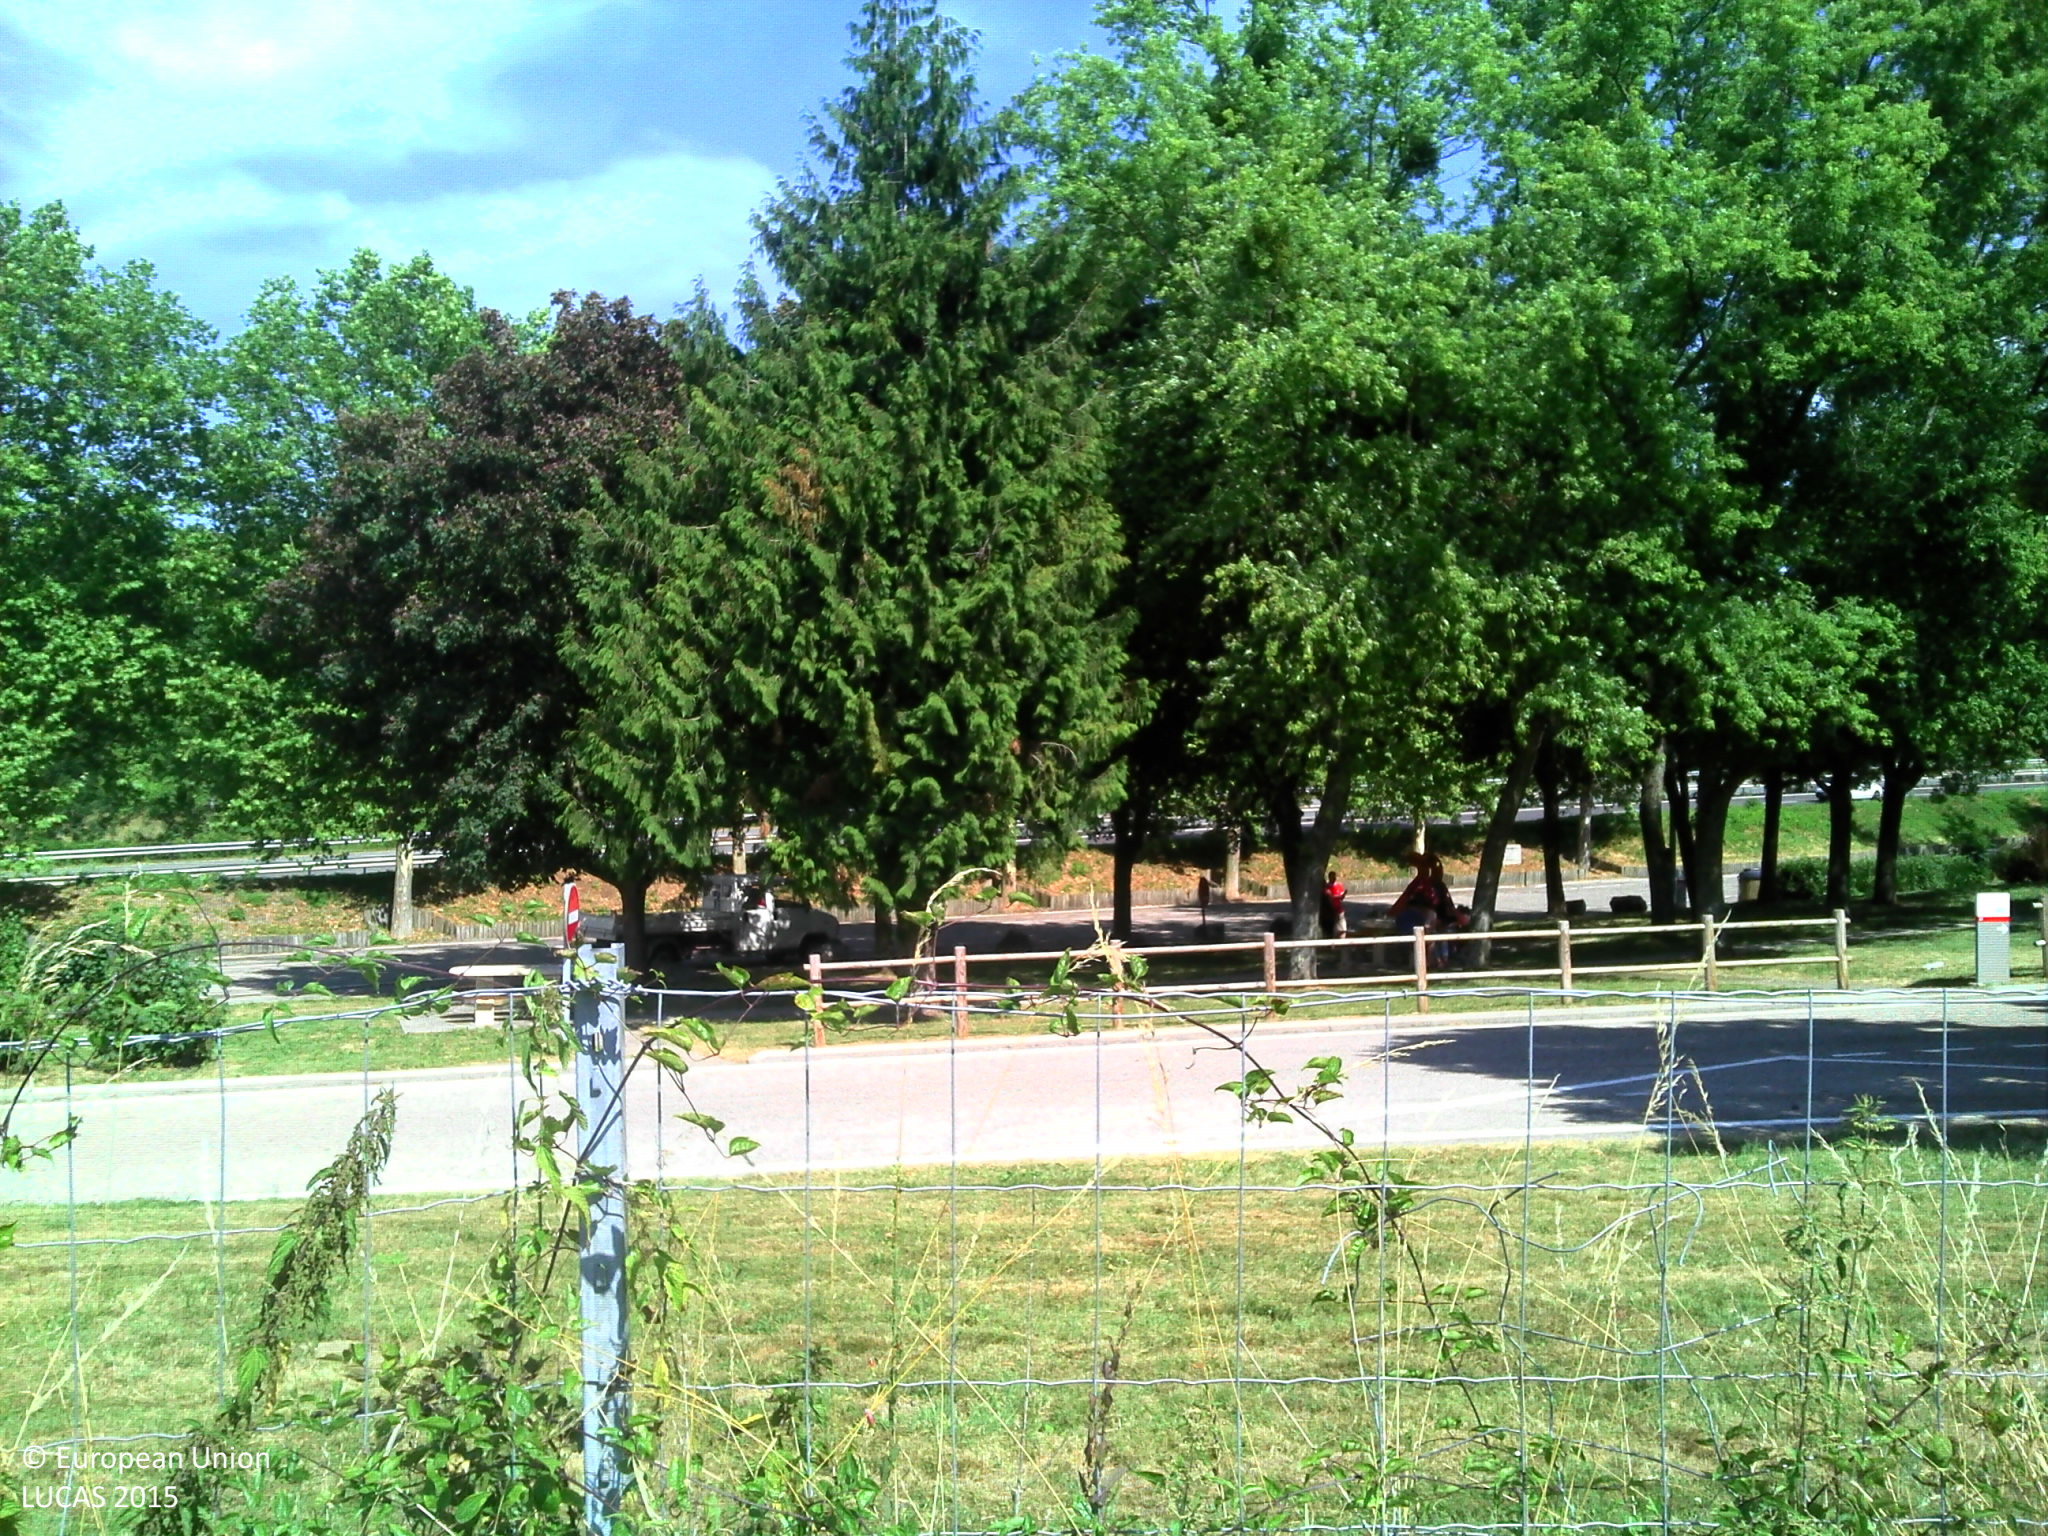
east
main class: Grassland
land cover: Grassland without tree/shrub cover
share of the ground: > 75 %
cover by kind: herbaceous plants 100 %
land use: Semi-natural and natural areas not in use
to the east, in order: Grassland without tree/shrub cover; Paved roads, cycling and walking lanes; Broadleaved woodland; Paved roads, cycling and walking lanes; Lines of trees; Paved roads, cycling and walking lanes; Grassland without tree/shrub cover; Broadleaved woodland; Grassland without tree/shrub cover; Lines of trees; Grassland without tree/shrub cover; Abandoned hedges; Shrubland without tree cover; Fences; Lucerne; Fences; Grassland without tree/shrub cover
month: July
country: FR
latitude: 45.5309
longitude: 5.4077
